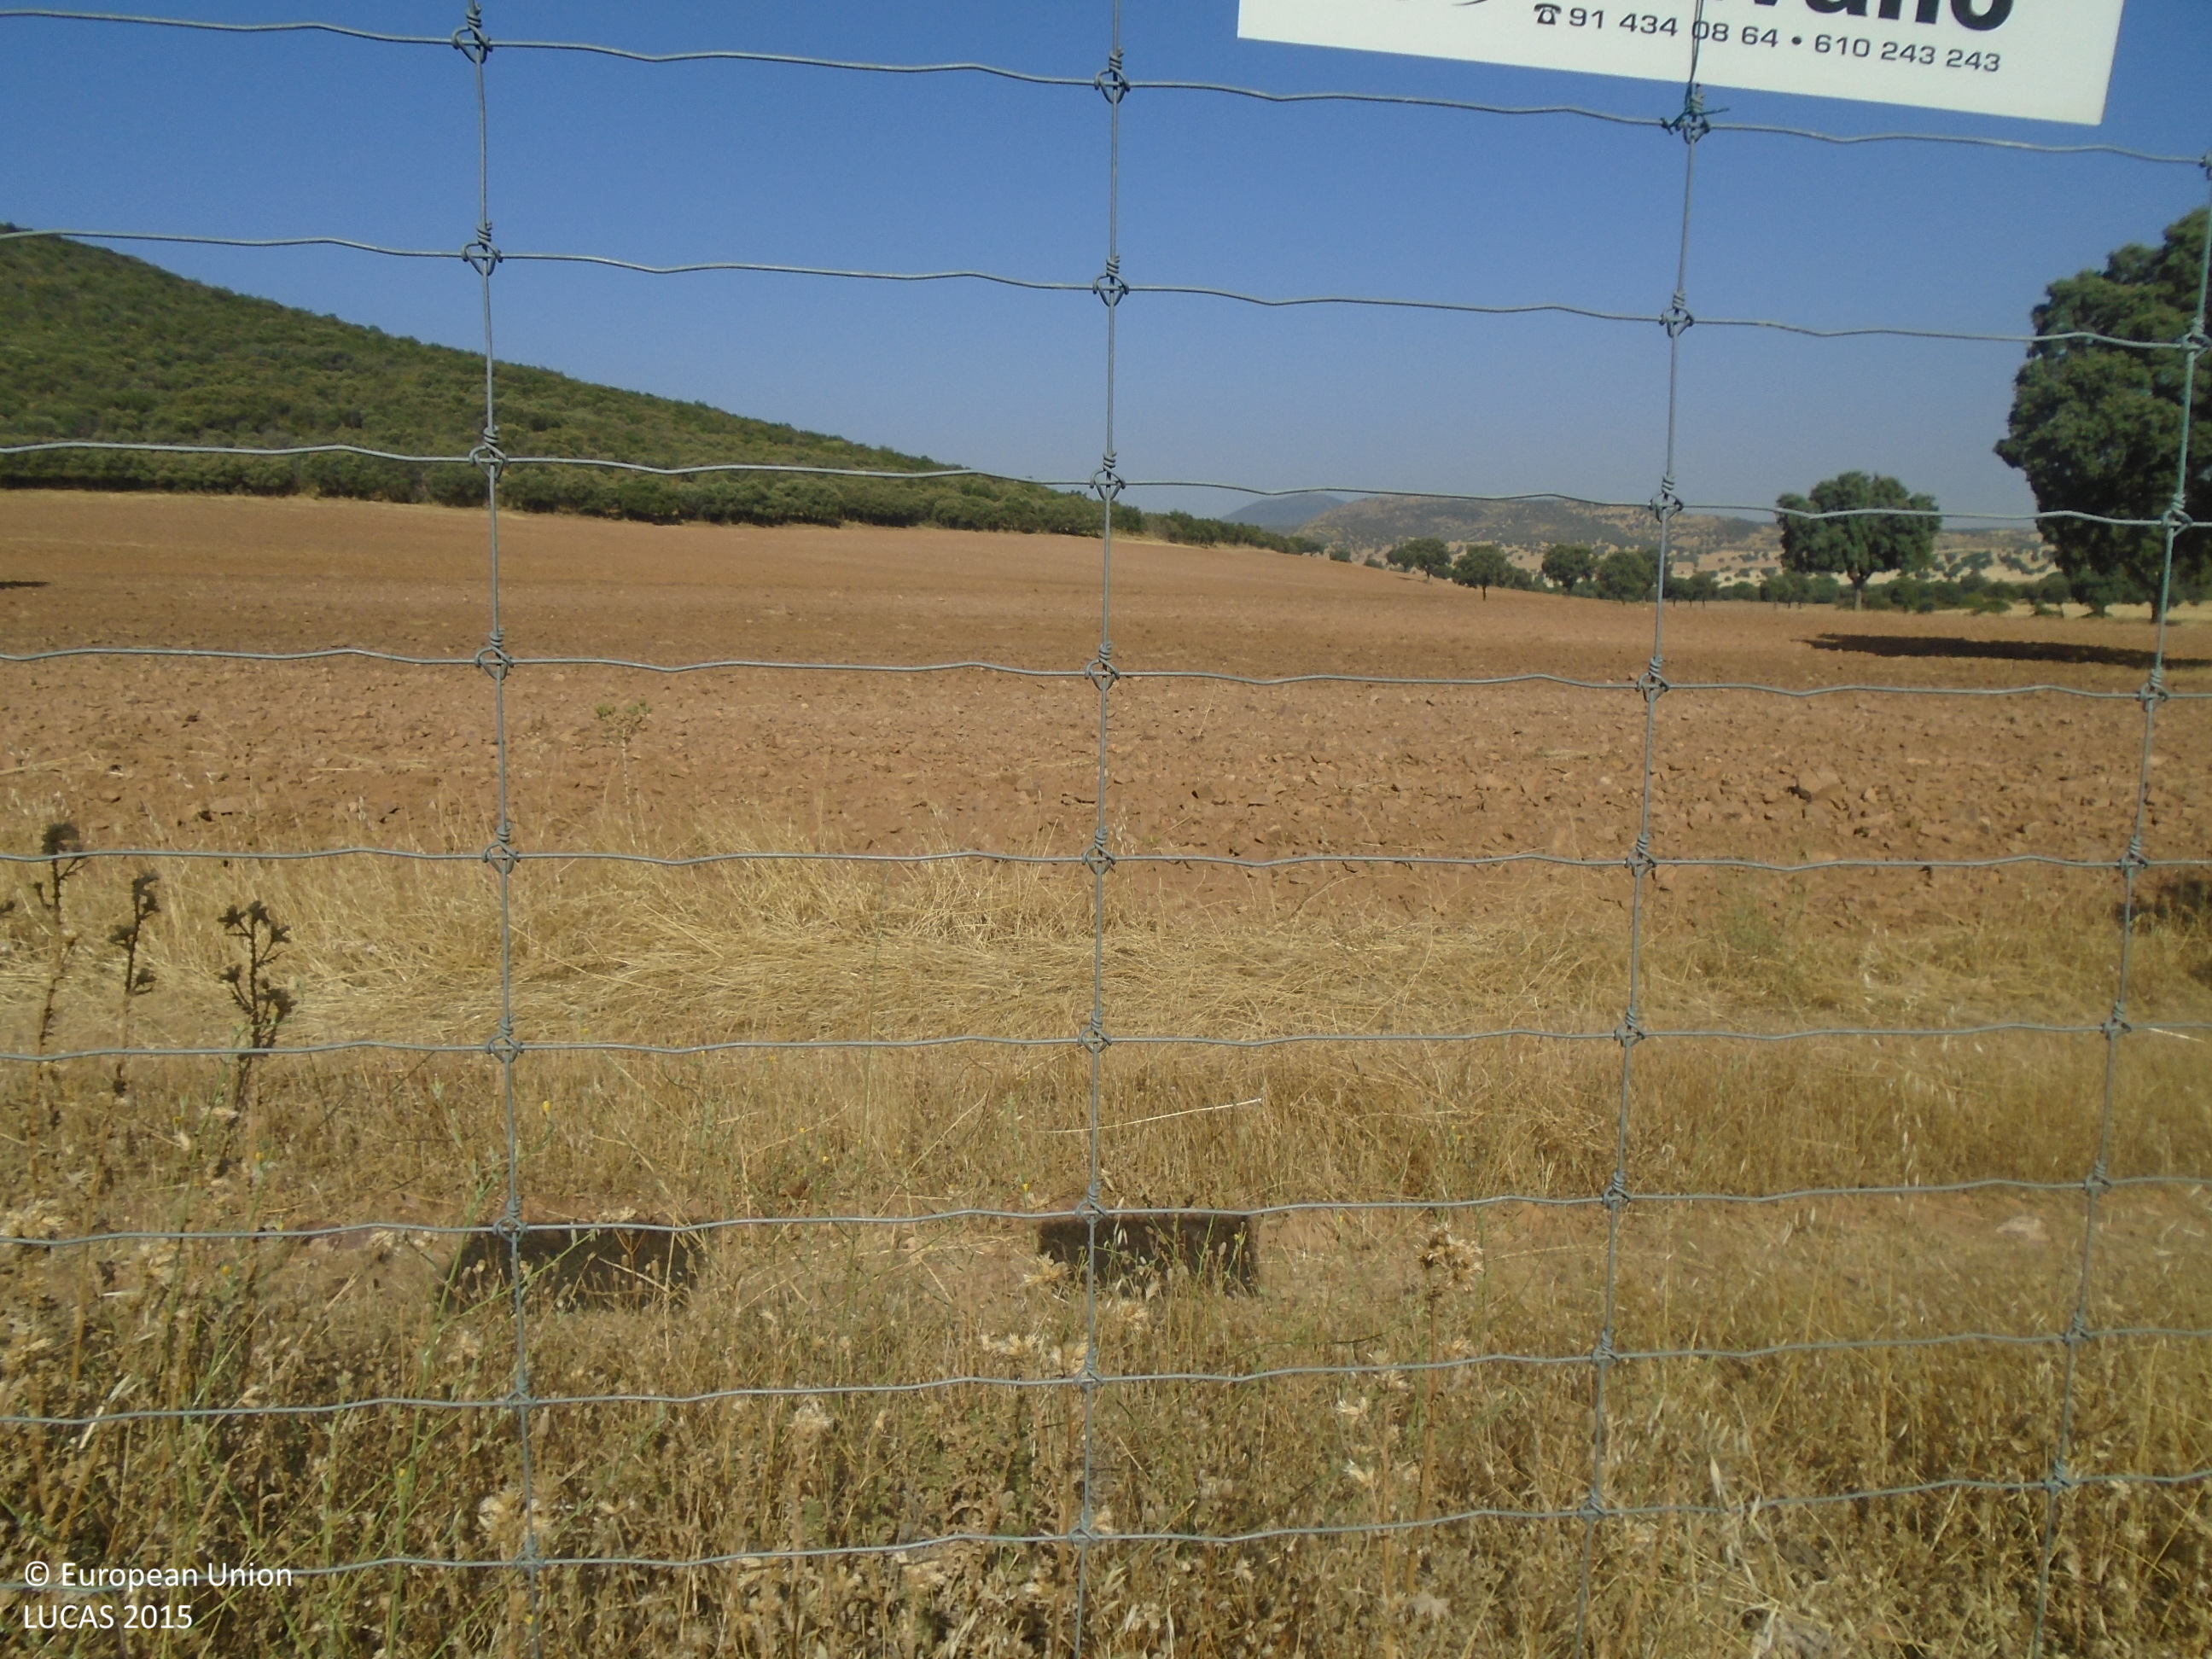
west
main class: Woodland
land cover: Broadleaved woodland
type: broadleaved evergreen forest
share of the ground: > 75 %
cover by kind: broadleaved forest trees 90 %, shrubs 10 %
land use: Semi-natural and natural areas not in use
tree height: > 5 m
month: July
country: ES
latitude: 39.3021
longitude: -3.6941
